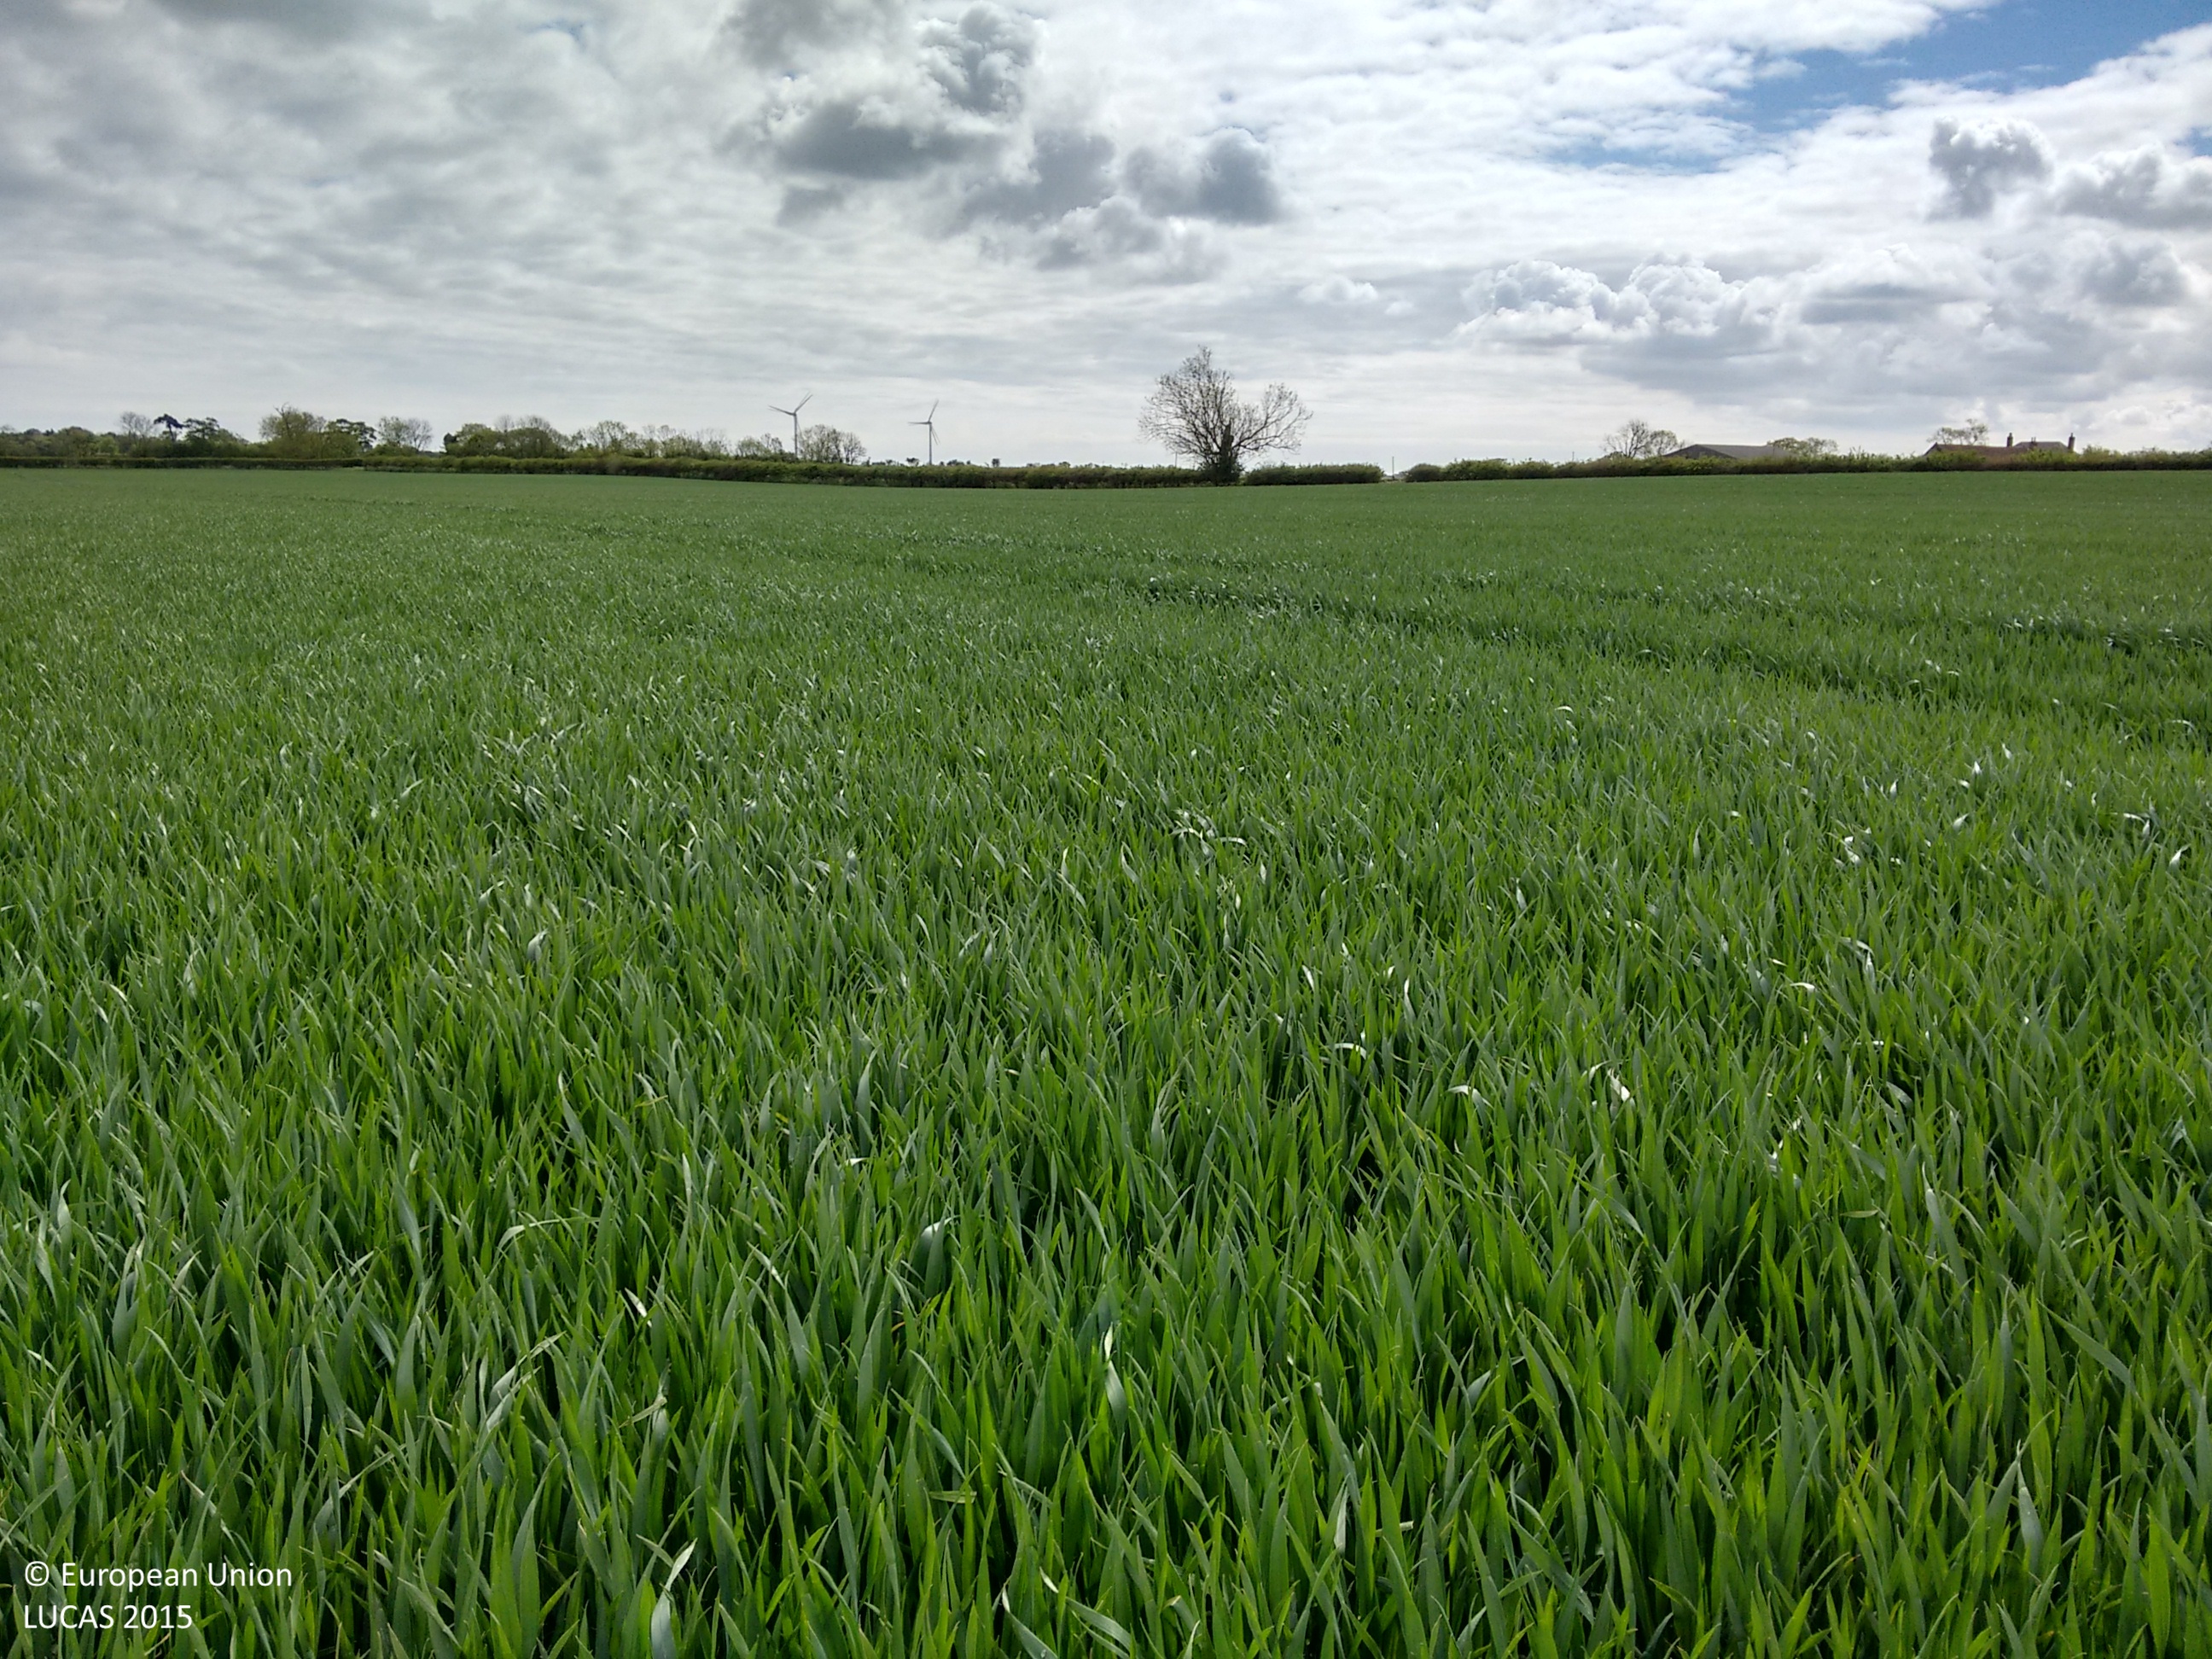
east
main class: Cropland
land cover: Common wheat
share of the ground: > 75 %
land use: Agriculture (excluding fallow land and kitchen gardens)
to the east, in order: Common wheat; Grass margins; Managed hedges; Grass margins; Common wheat
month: May
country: GB
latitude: 53.5101
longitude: -0.0294
